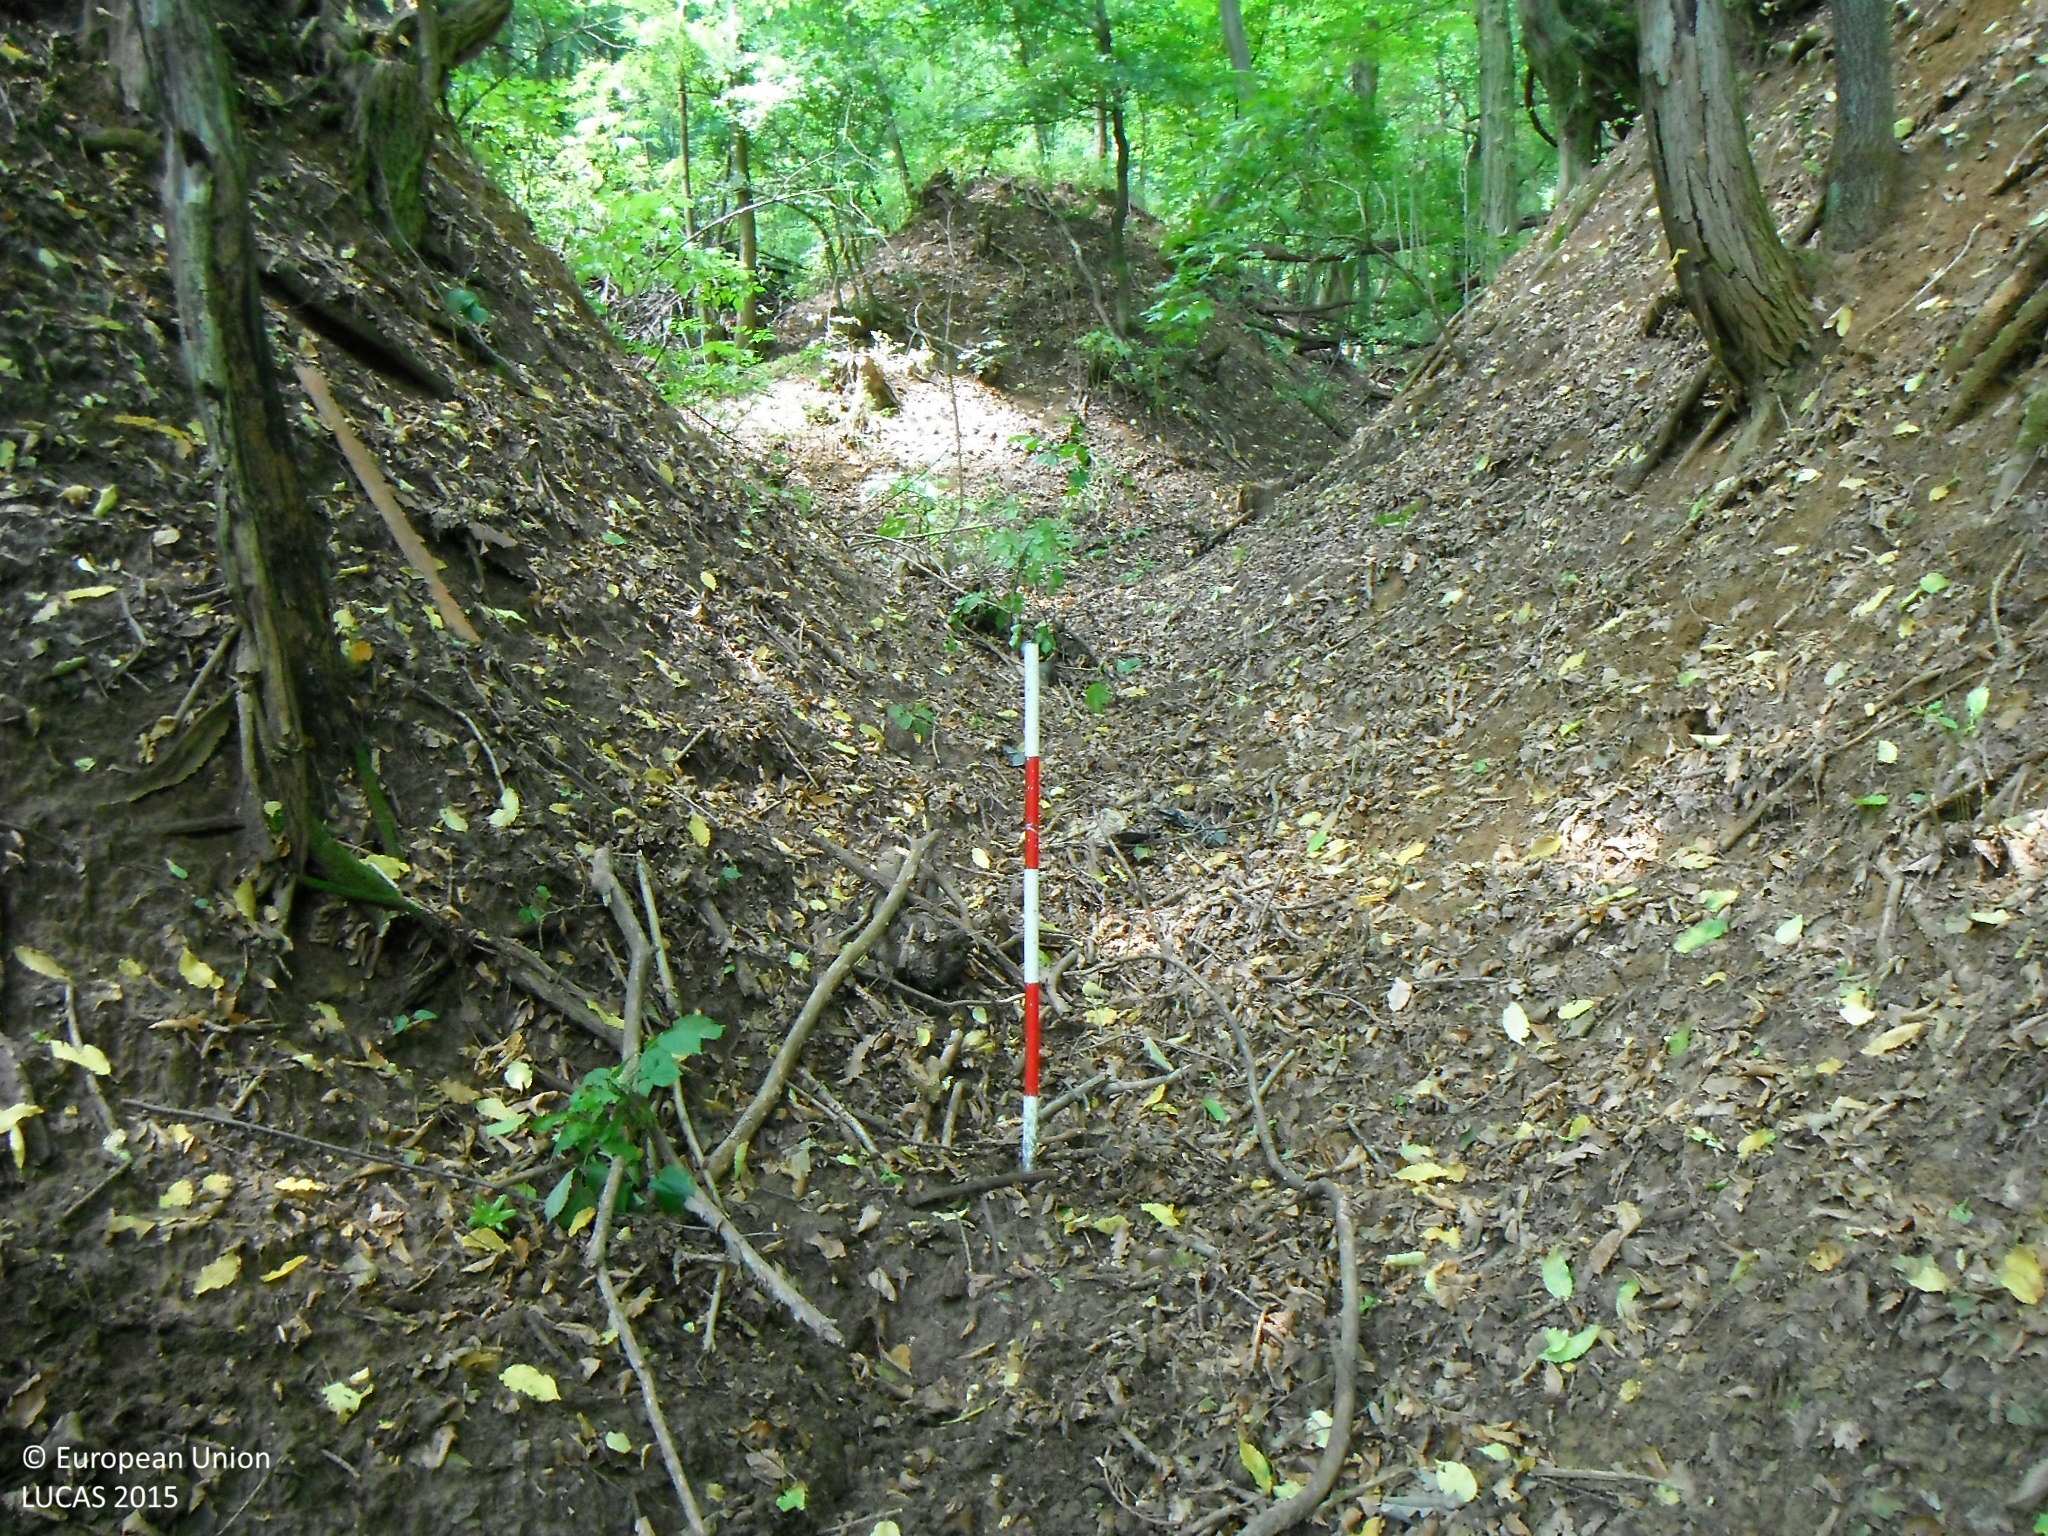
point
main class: Woodland
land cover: Broadleaved woodland
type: exotic forest
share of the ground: > 75 %
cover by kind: broadleaved forest trees 100 %
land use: Forestry
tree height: > 5 m
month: July
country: SK
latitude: 48.2054
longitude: 19.9723
